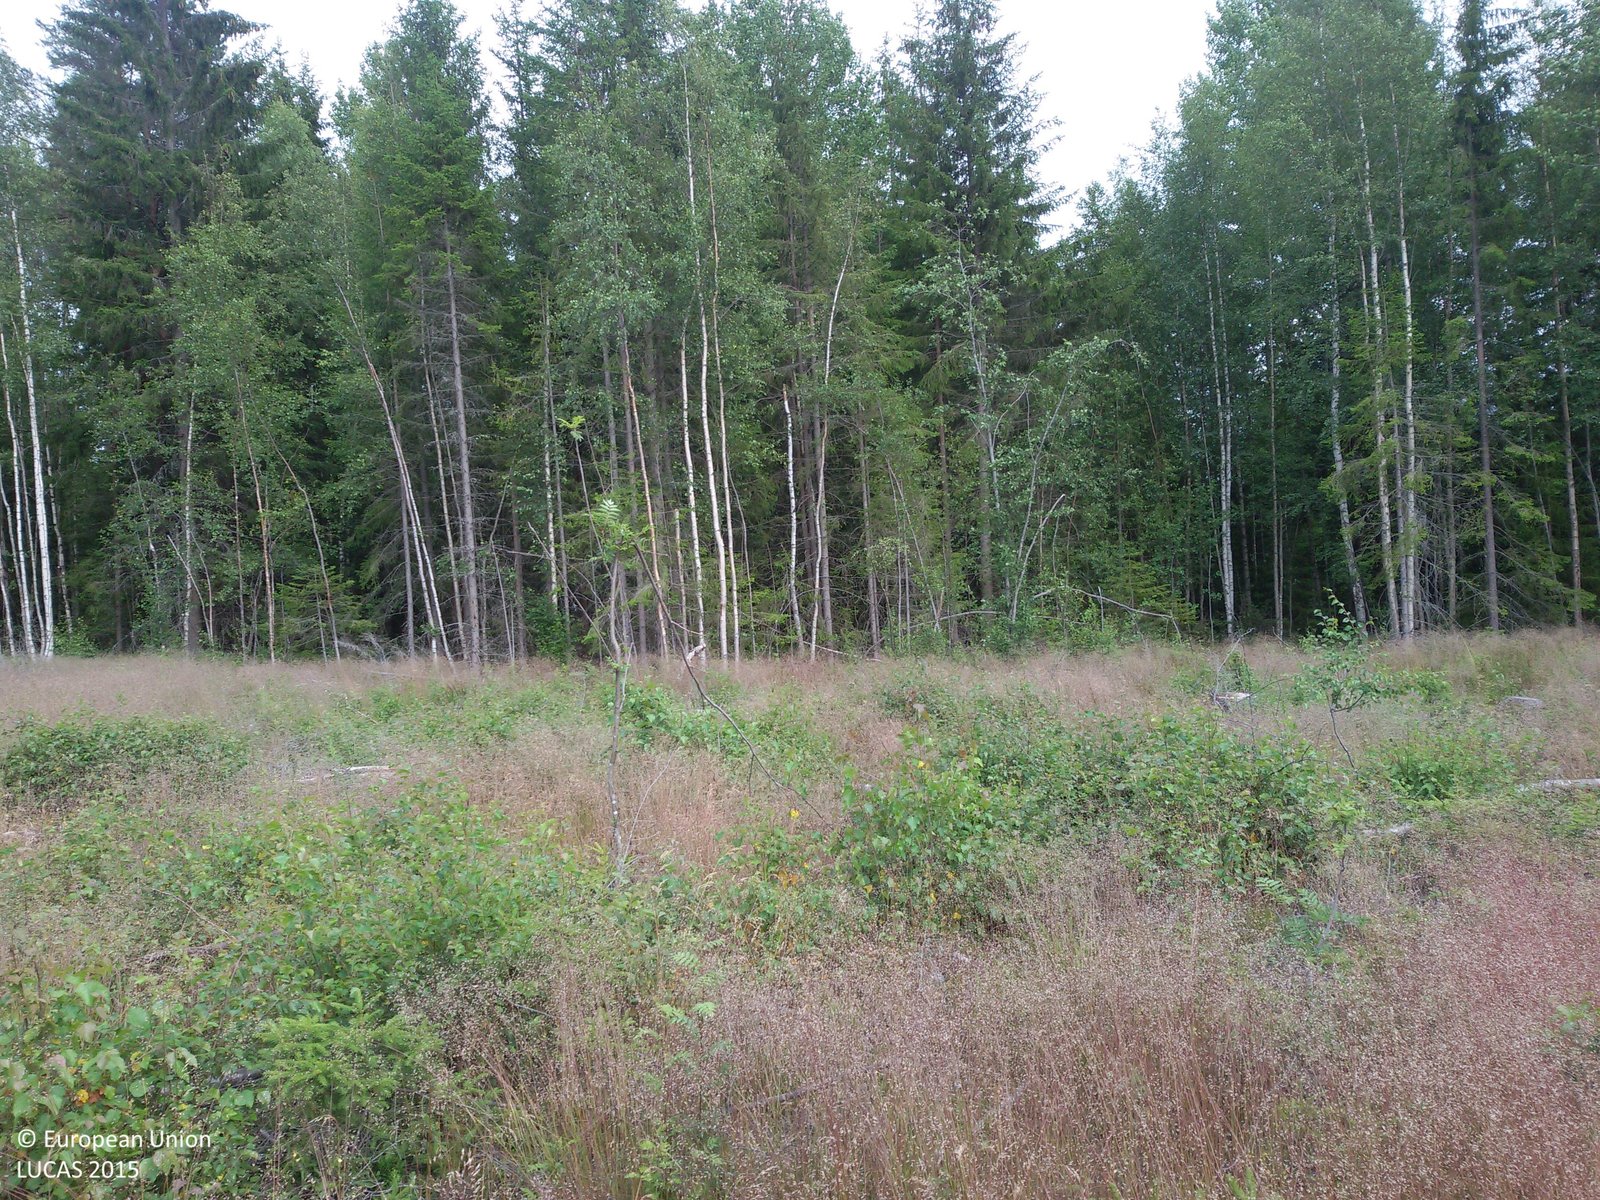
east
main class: Woodland
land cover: Spruce dominated mixed woodland
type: boreal forest
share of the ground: 25 - 50 %
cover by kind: herbaceous plants 50 %, broadleaved forest trees 30 %, coniferous forest trees 20 %
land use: Forestry
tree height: < 5 m
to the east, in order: Spruce dominated mixed woodland; Tracks; Spruce dominated mixed woodland; Broadleaved woodland
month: July
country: SE
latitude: 60.4389
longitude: 15.3848
